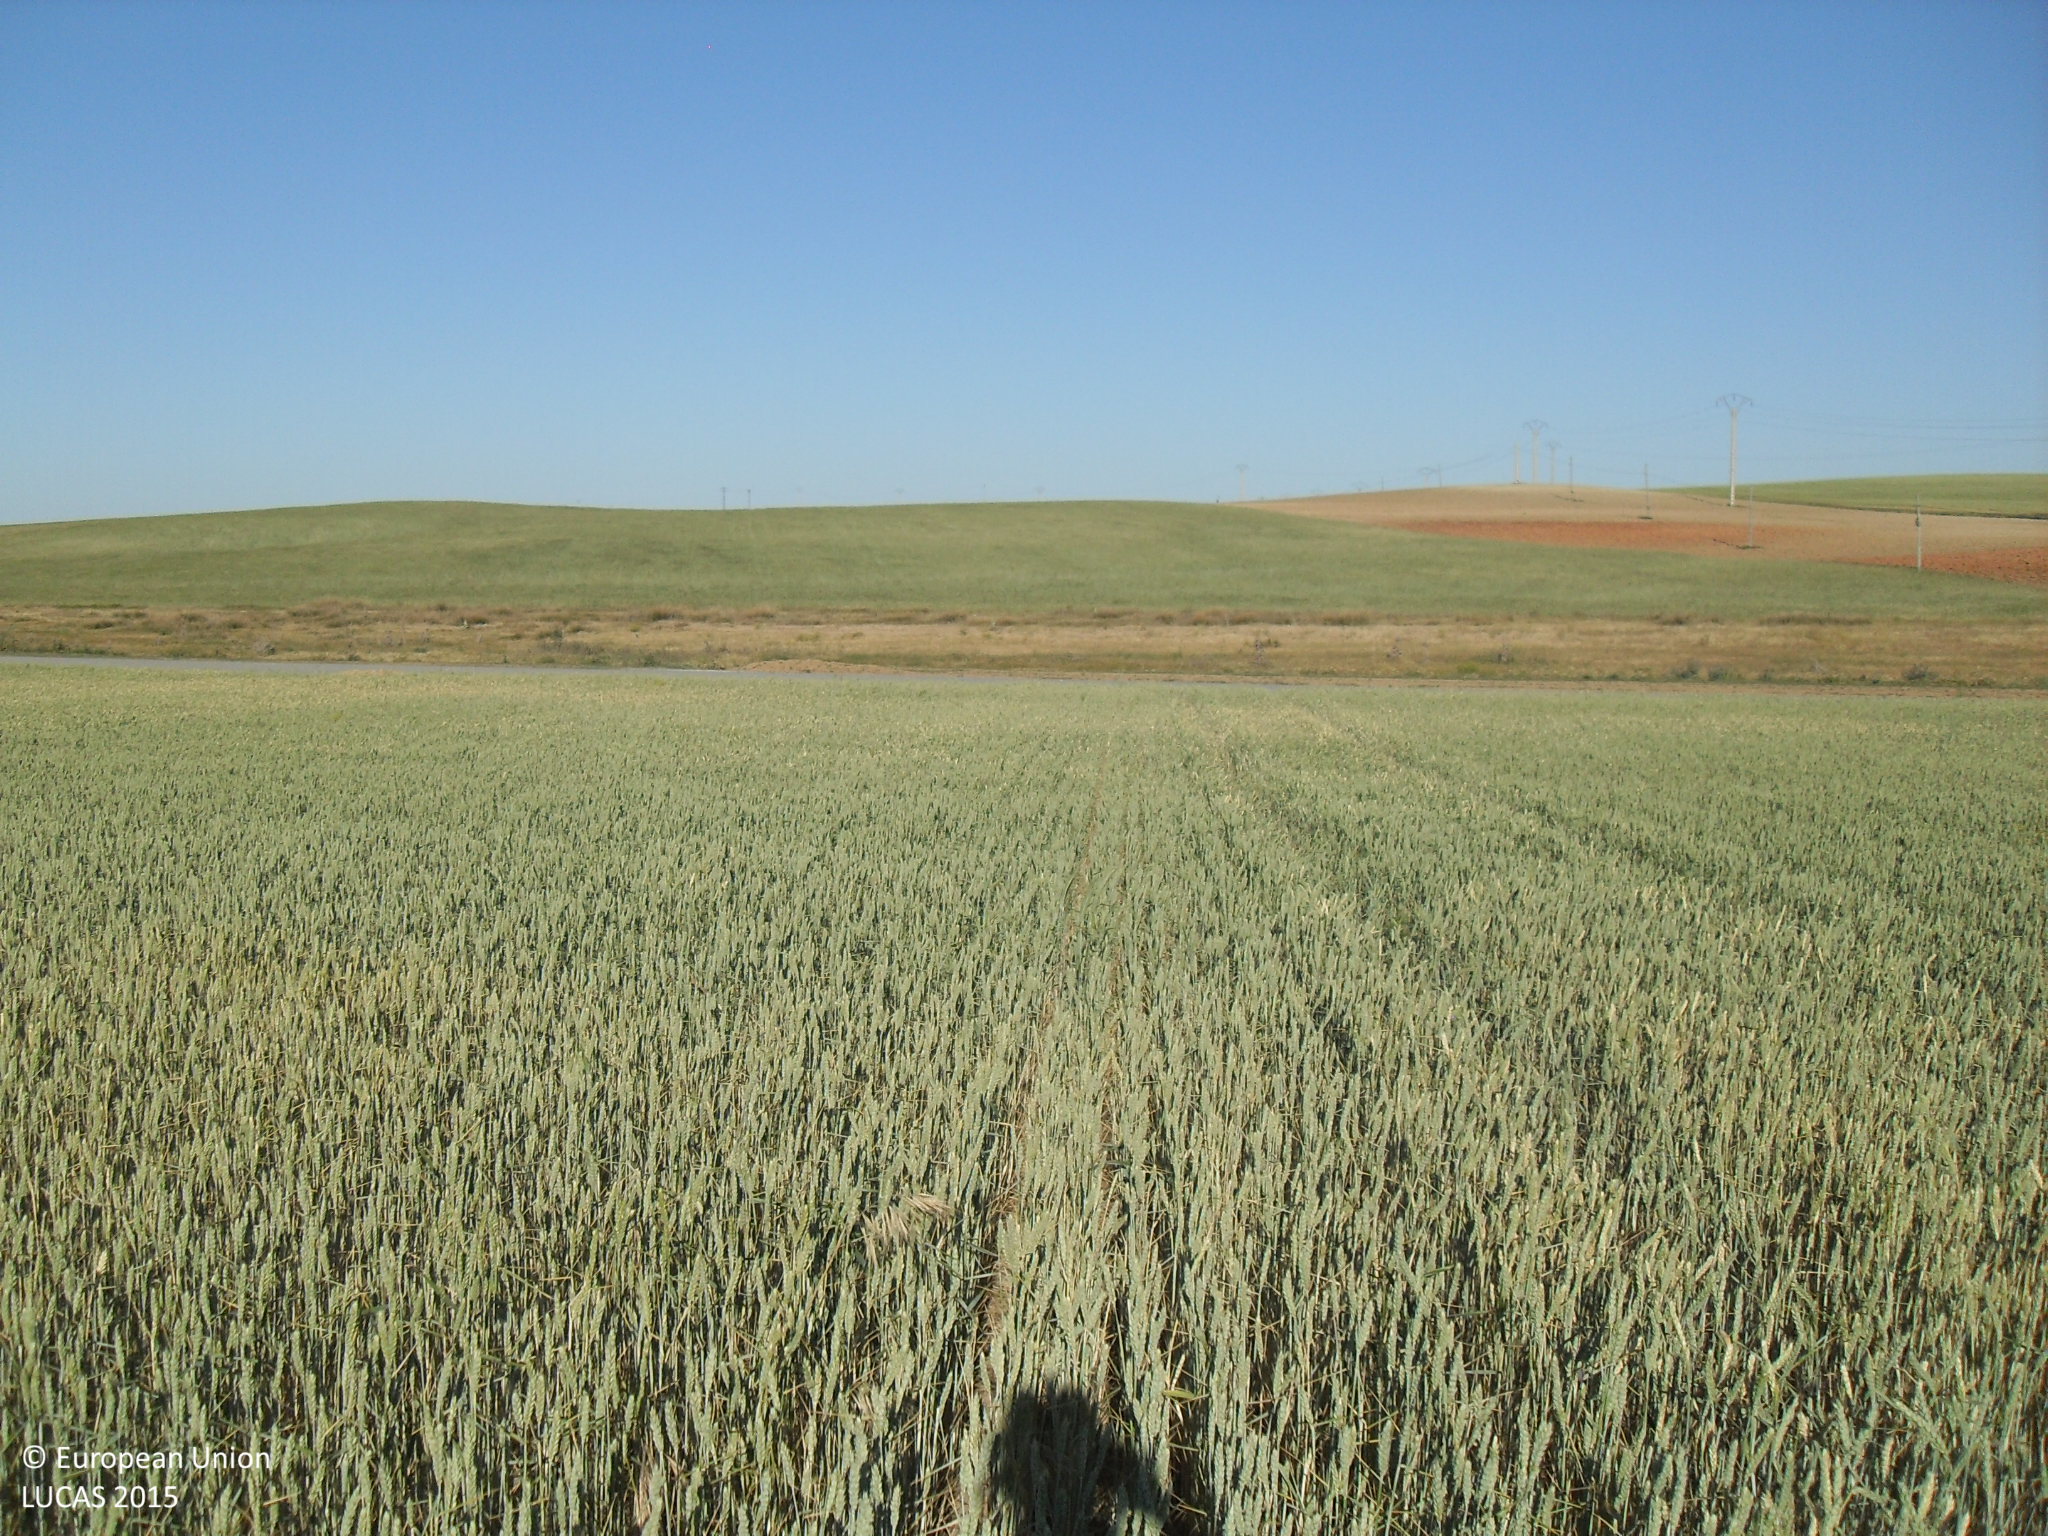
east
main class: Cropland
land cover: Common wheat
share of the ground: > 75 %
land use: Agriculture (excluding fallow land and kitchen gardens)
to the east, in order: Common wheat; Grass margins; Paved roads, cycling and walking lanes; Grass margins; Spontaneously vegetated surfaces; Inland fresh running water; Rye
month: May
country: ES
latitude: 41.0452
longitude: -5.2869
